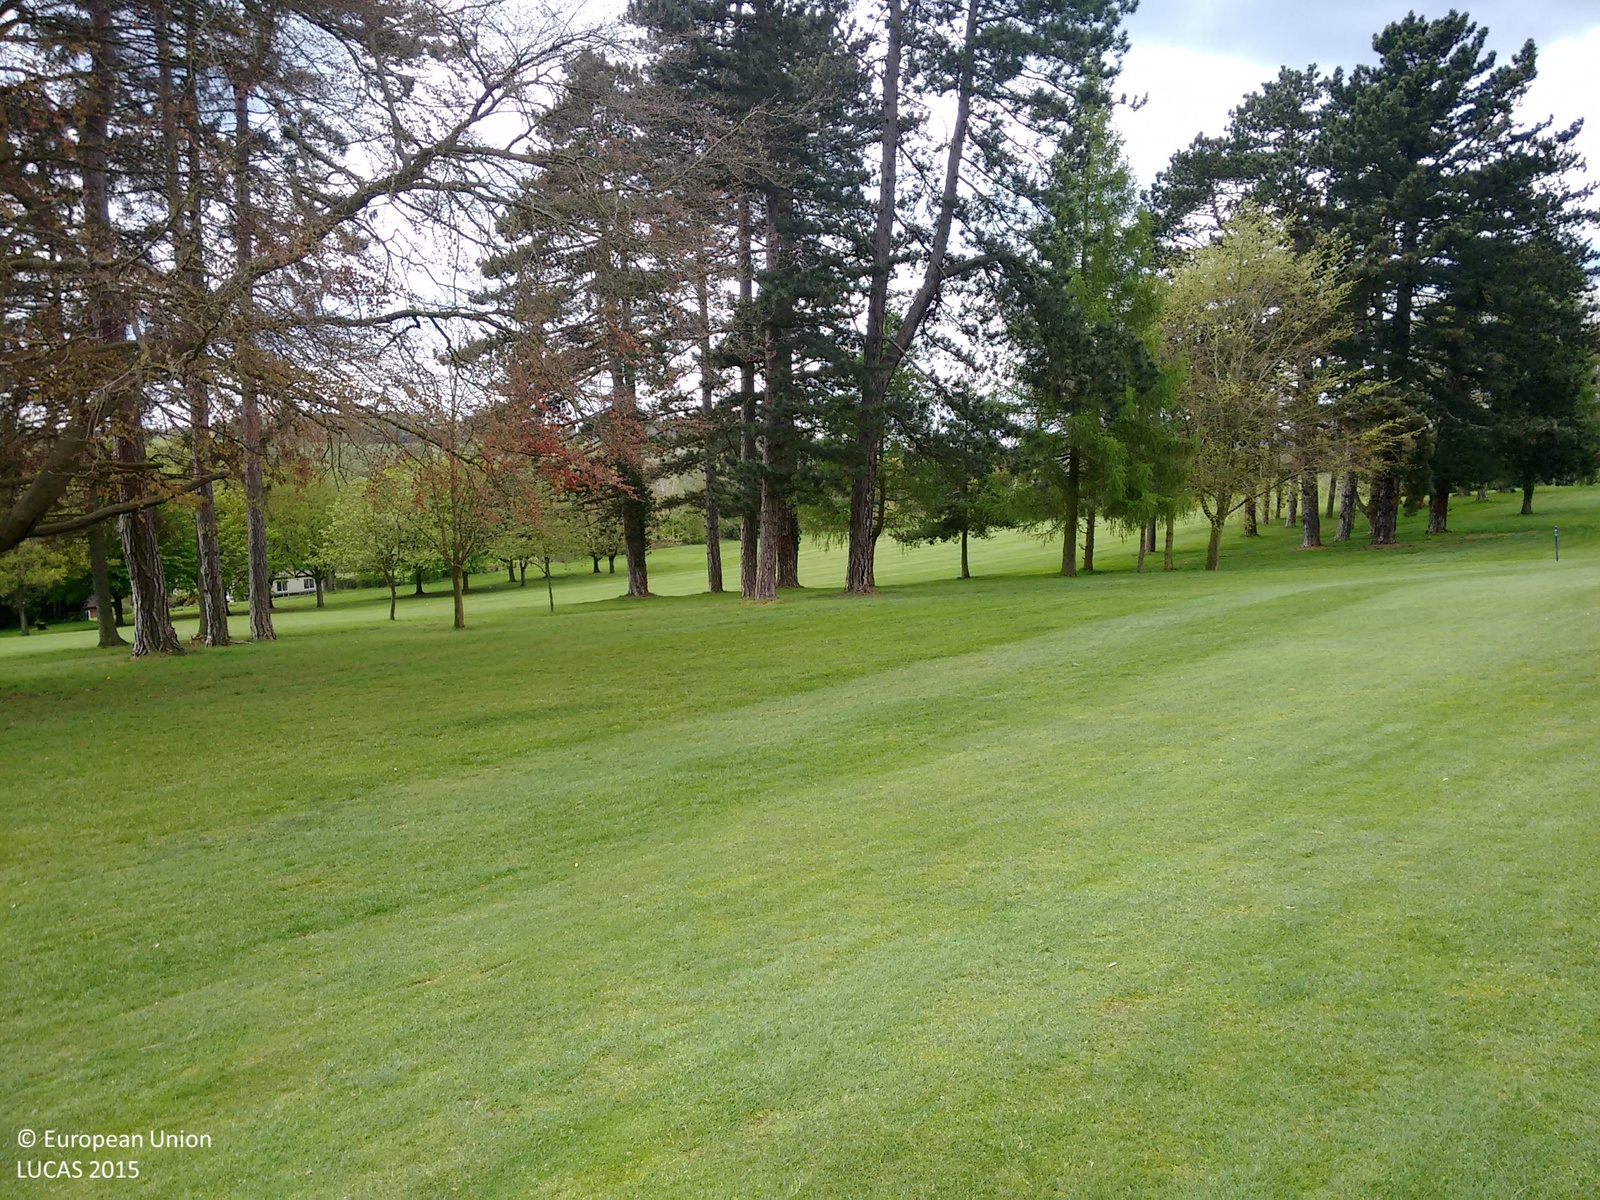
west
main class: Grassland
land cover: Grassland without tree/shrub cover
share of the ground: > 75 %
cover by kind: herbaceous plants 100 %
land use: Sport
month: April
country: GB
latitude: 51.6498
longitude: -0.5755
